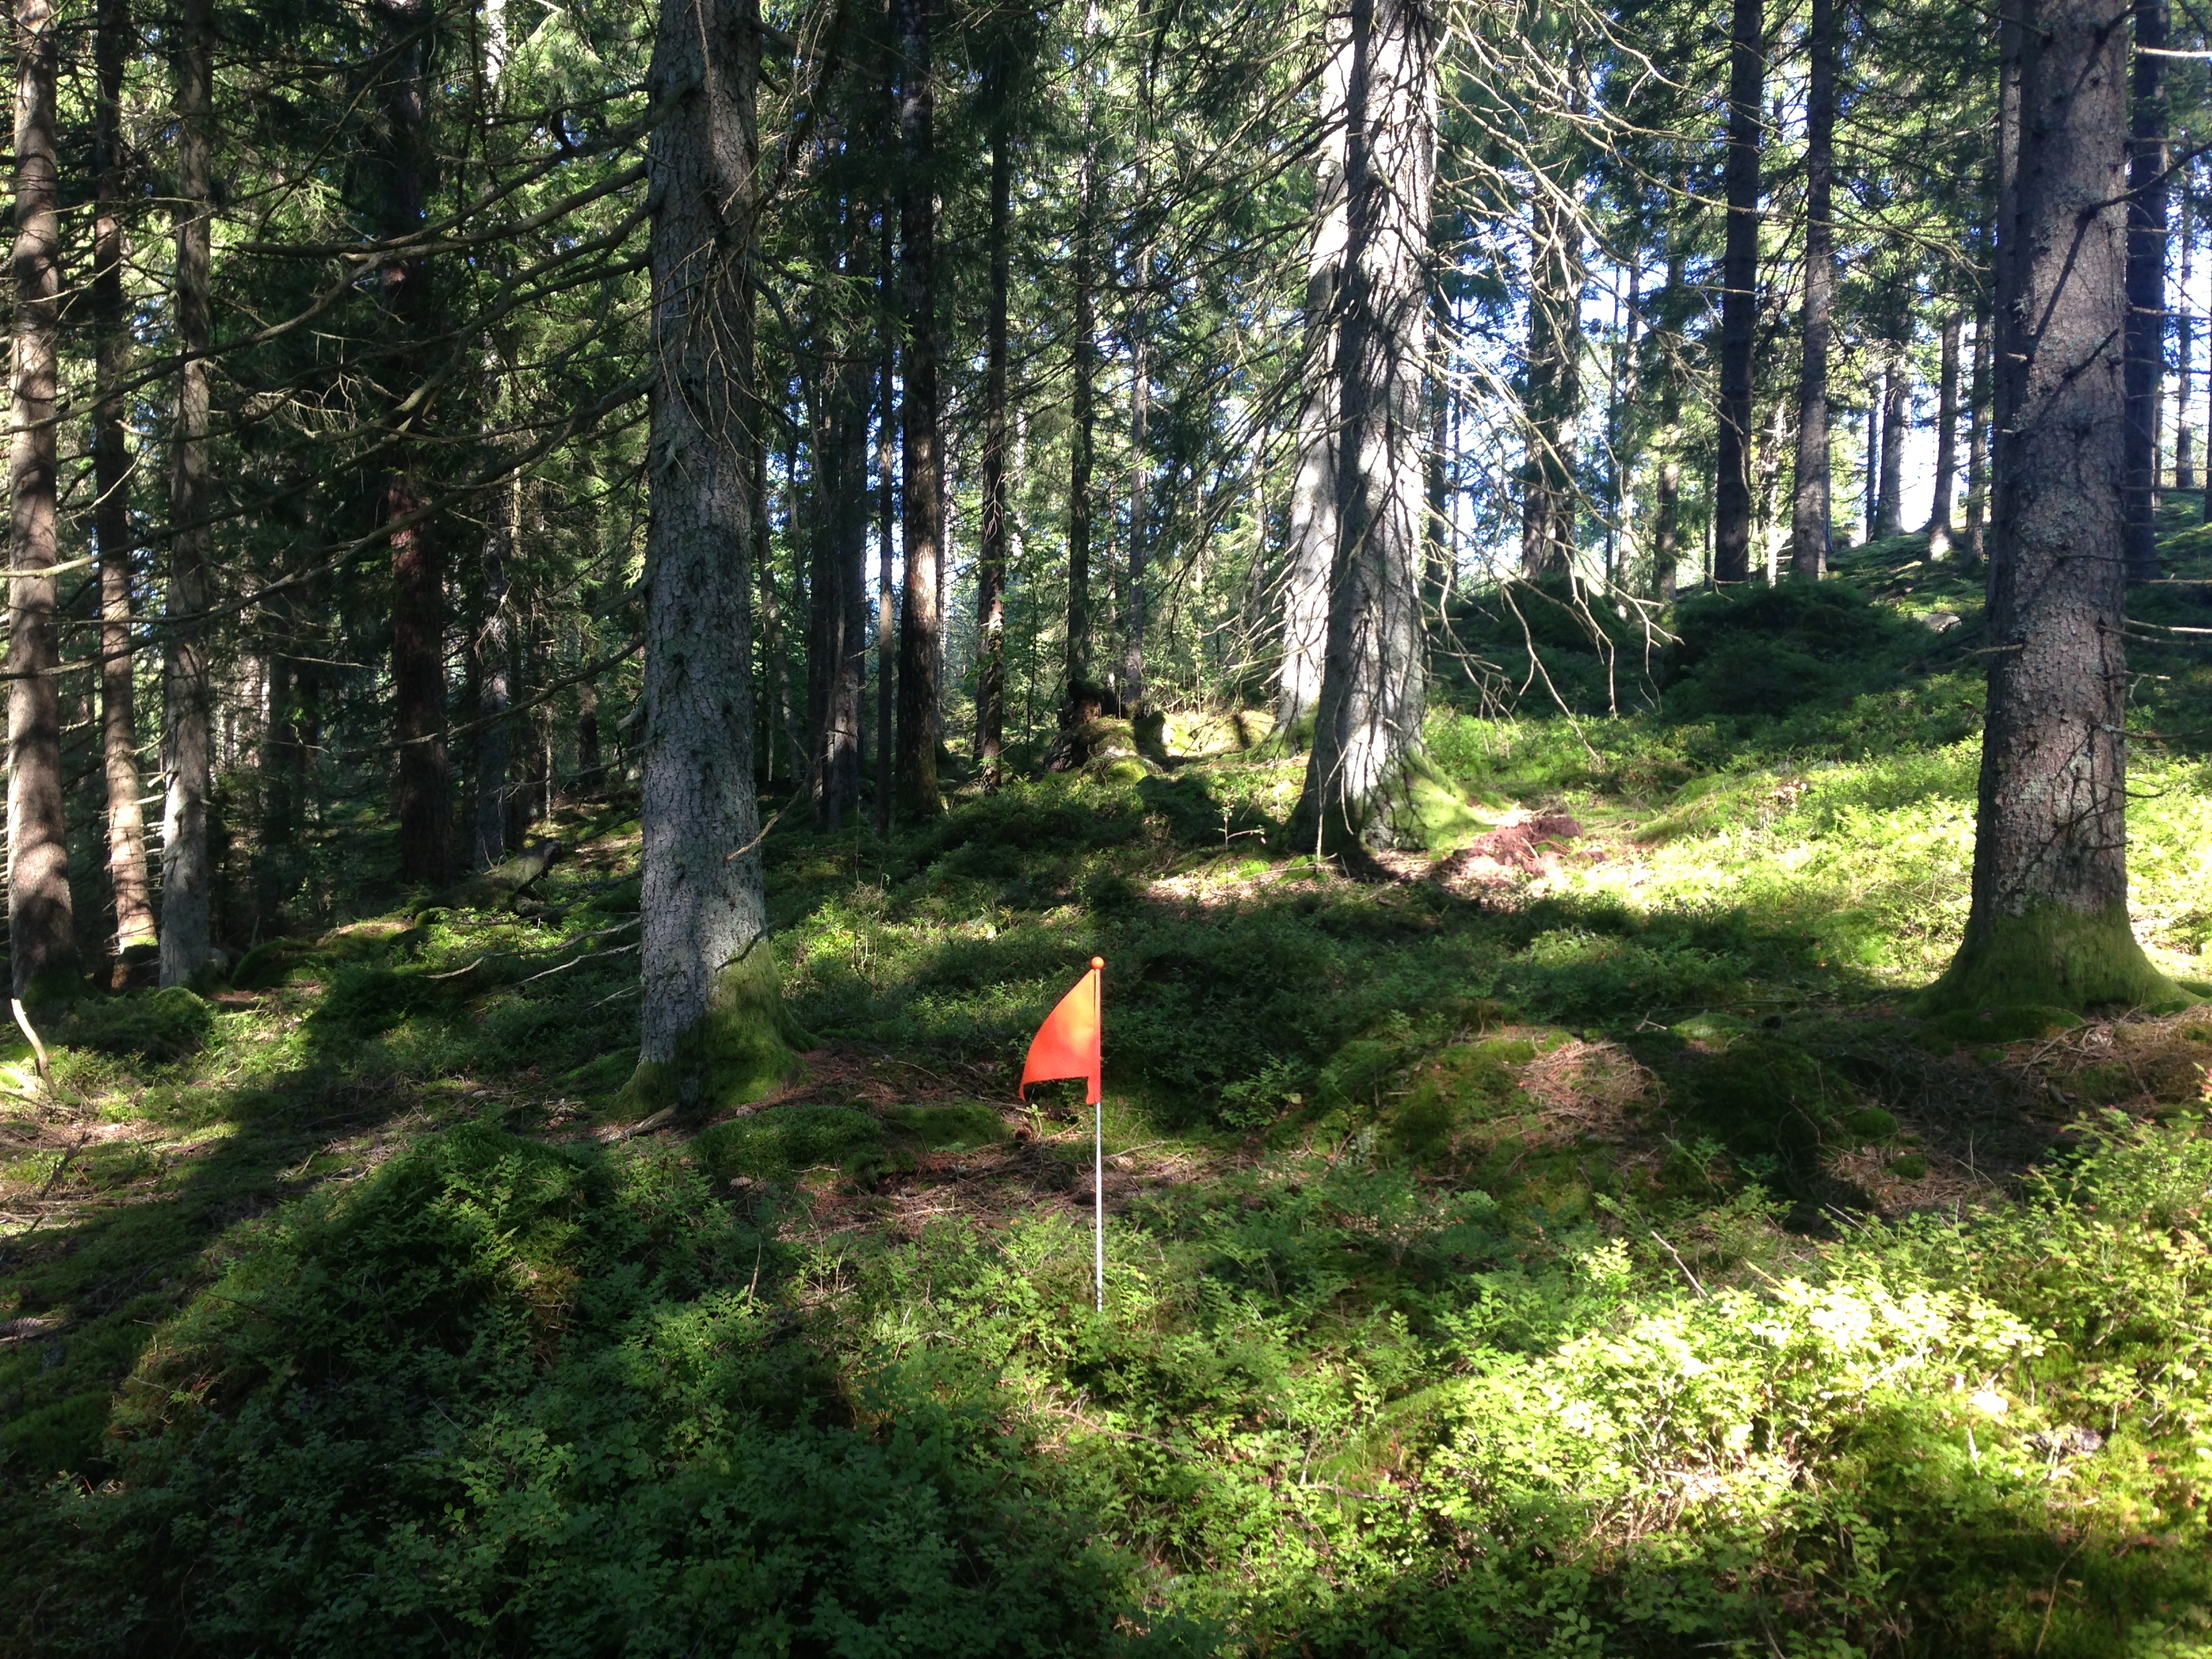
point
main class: Woodland
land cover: Spruce dominated coniferous woodland
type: boreal forest
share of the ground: > 75 %
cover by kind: coniferous forest trees 80 %, shrubs 20 %
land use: Forestry
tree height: > 5 m
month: September
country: SE
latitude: 57.1910
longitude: 13.2229
